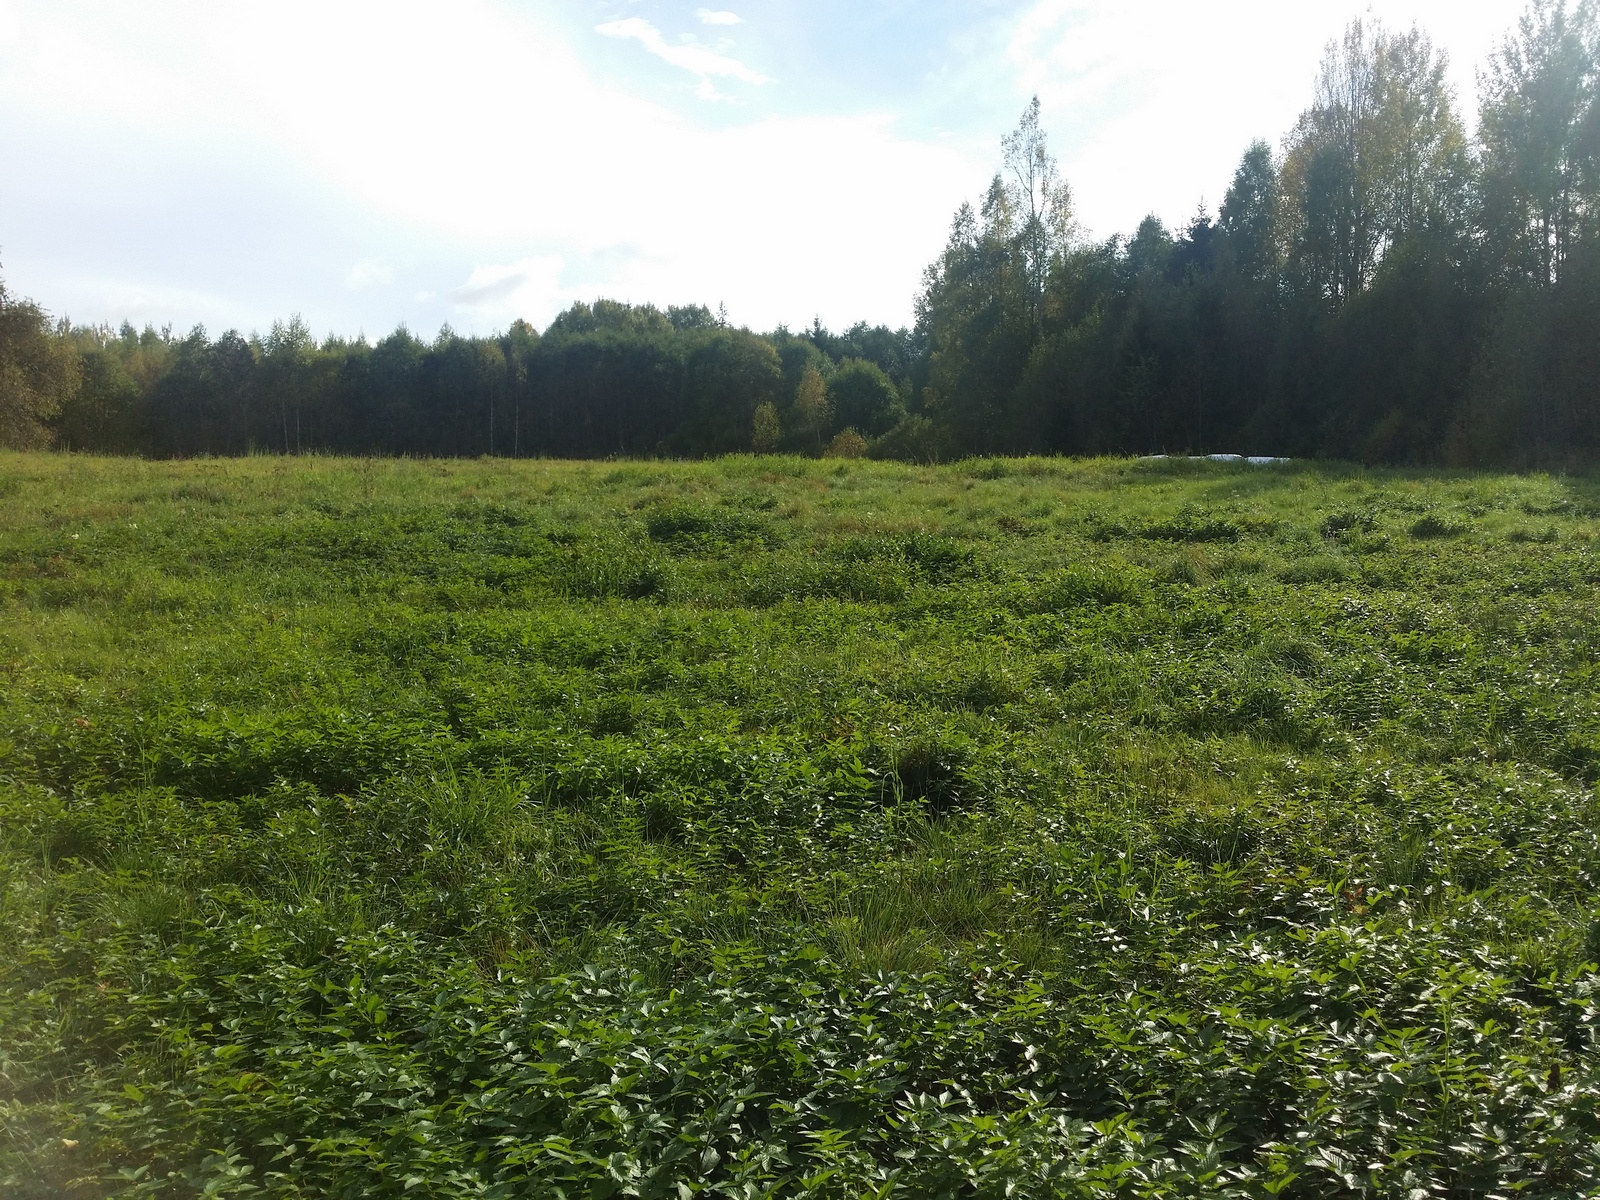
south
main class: Grassland
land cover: Spontaneously vegetated surfaces
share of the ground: > 75 %
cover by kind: herbaceous plants 100 %
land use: Agriculture (excluding fallow land and kitchen gardens)
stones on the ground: < 10 %
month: September
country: LV
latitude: 57.3685
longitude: 27.3801
